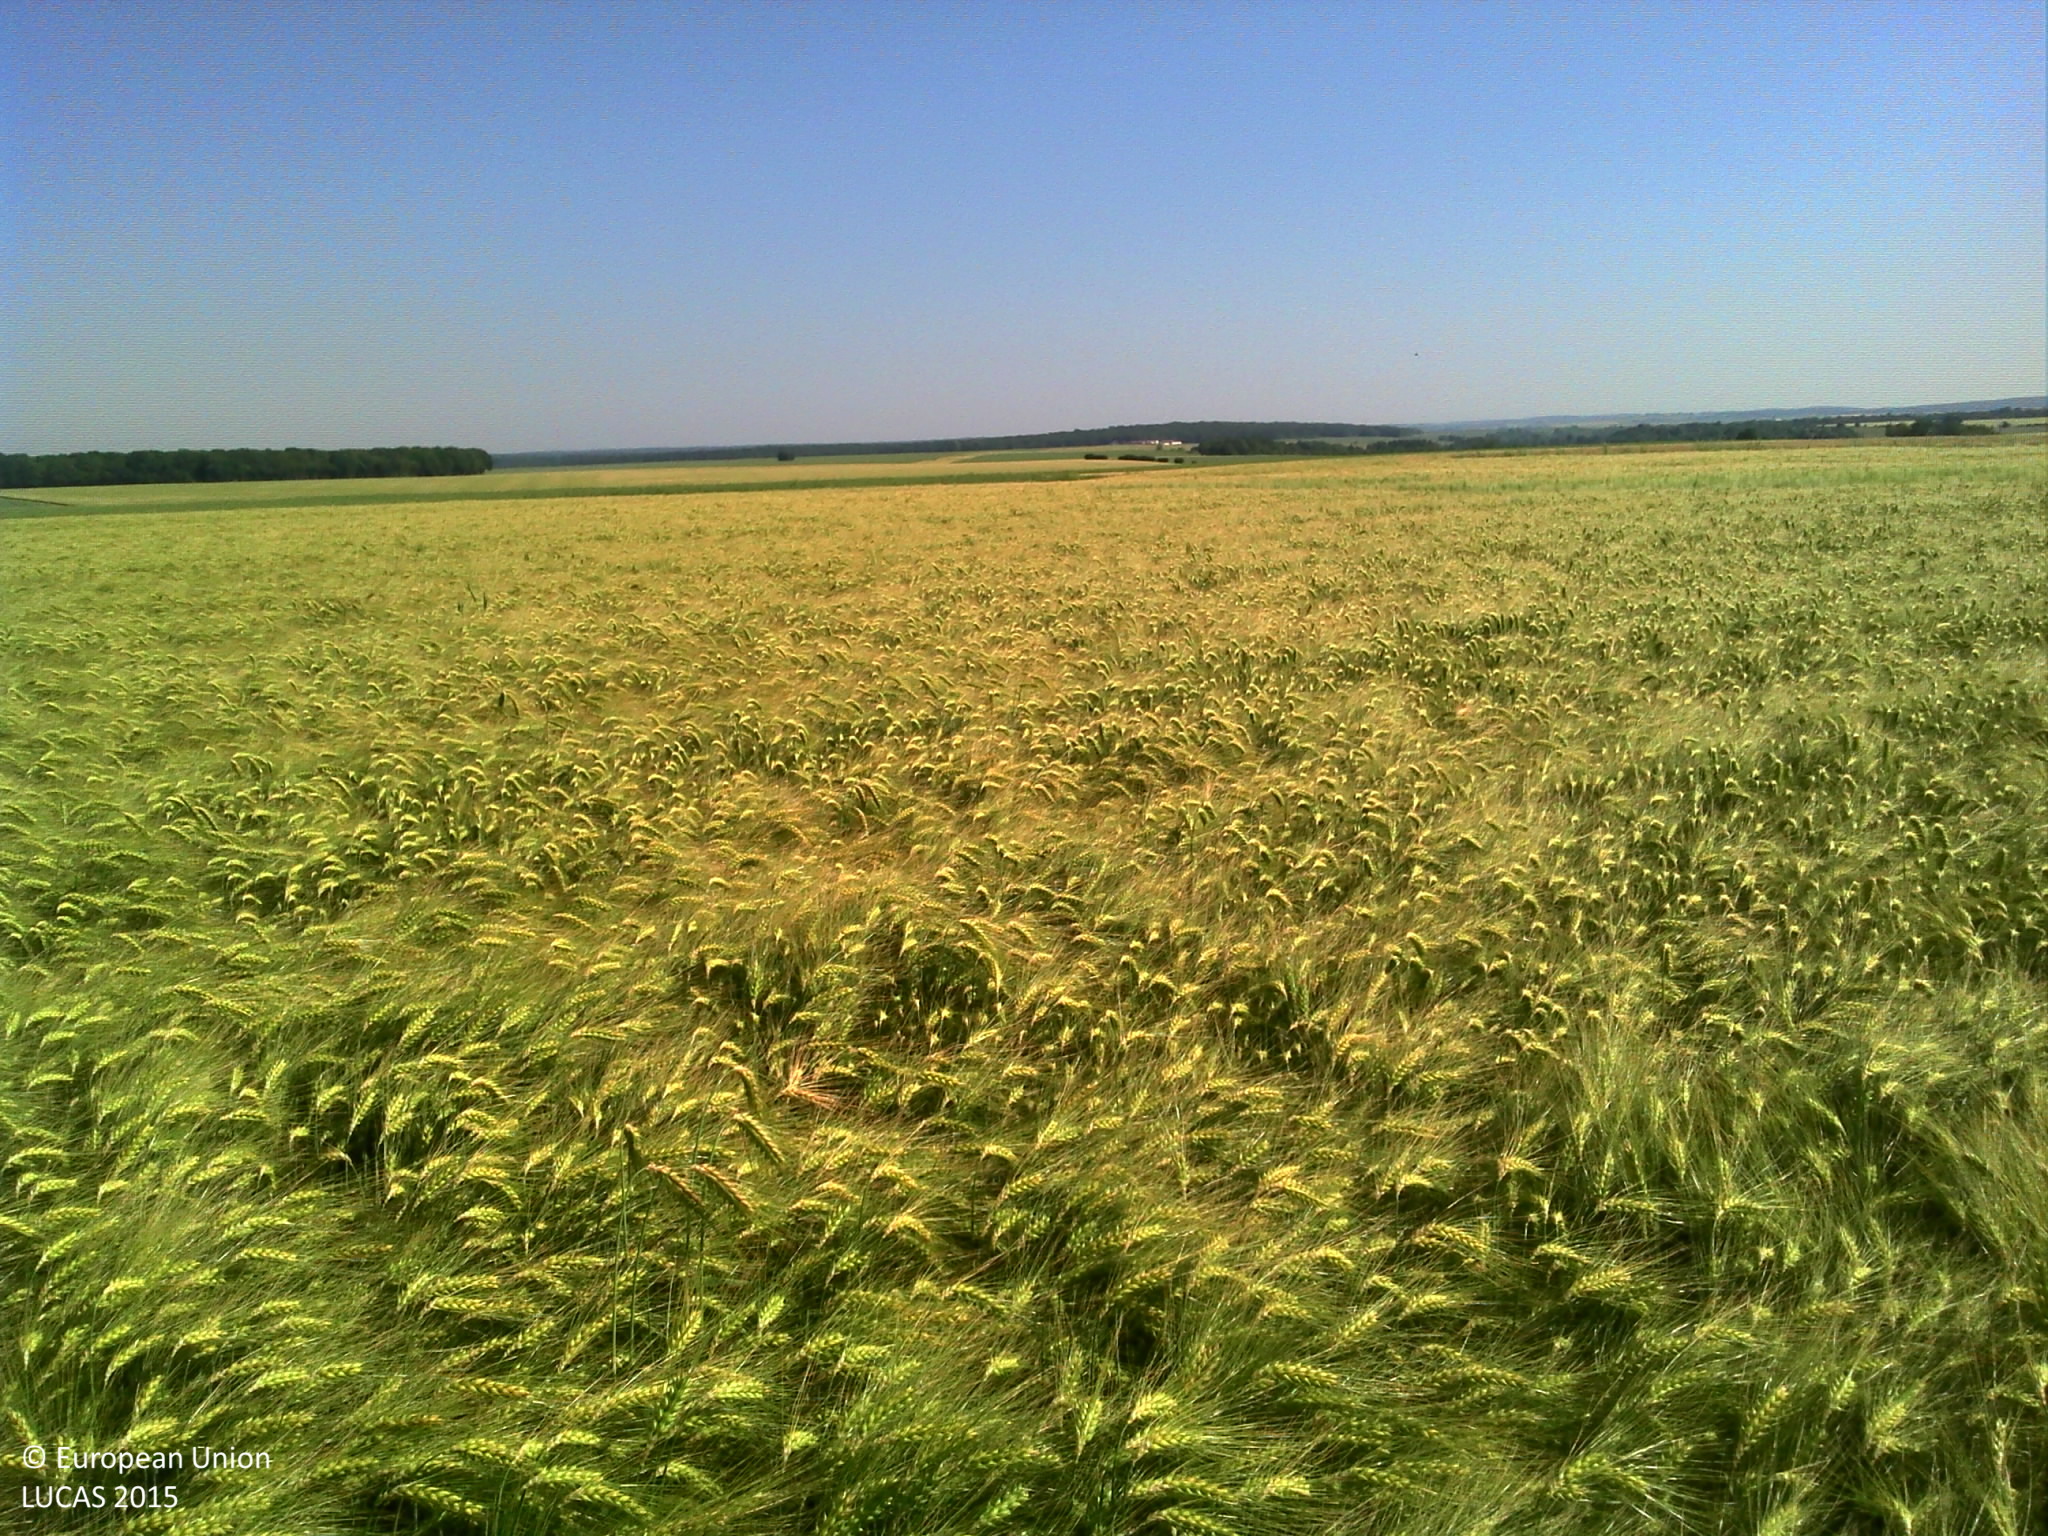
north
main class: Cropland
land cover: Barley
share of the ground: > 75 %
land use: Agriculture (excluding fallow land and kitchen gardens)
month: June
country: FR
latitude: 48.3764
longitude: 4.9085
